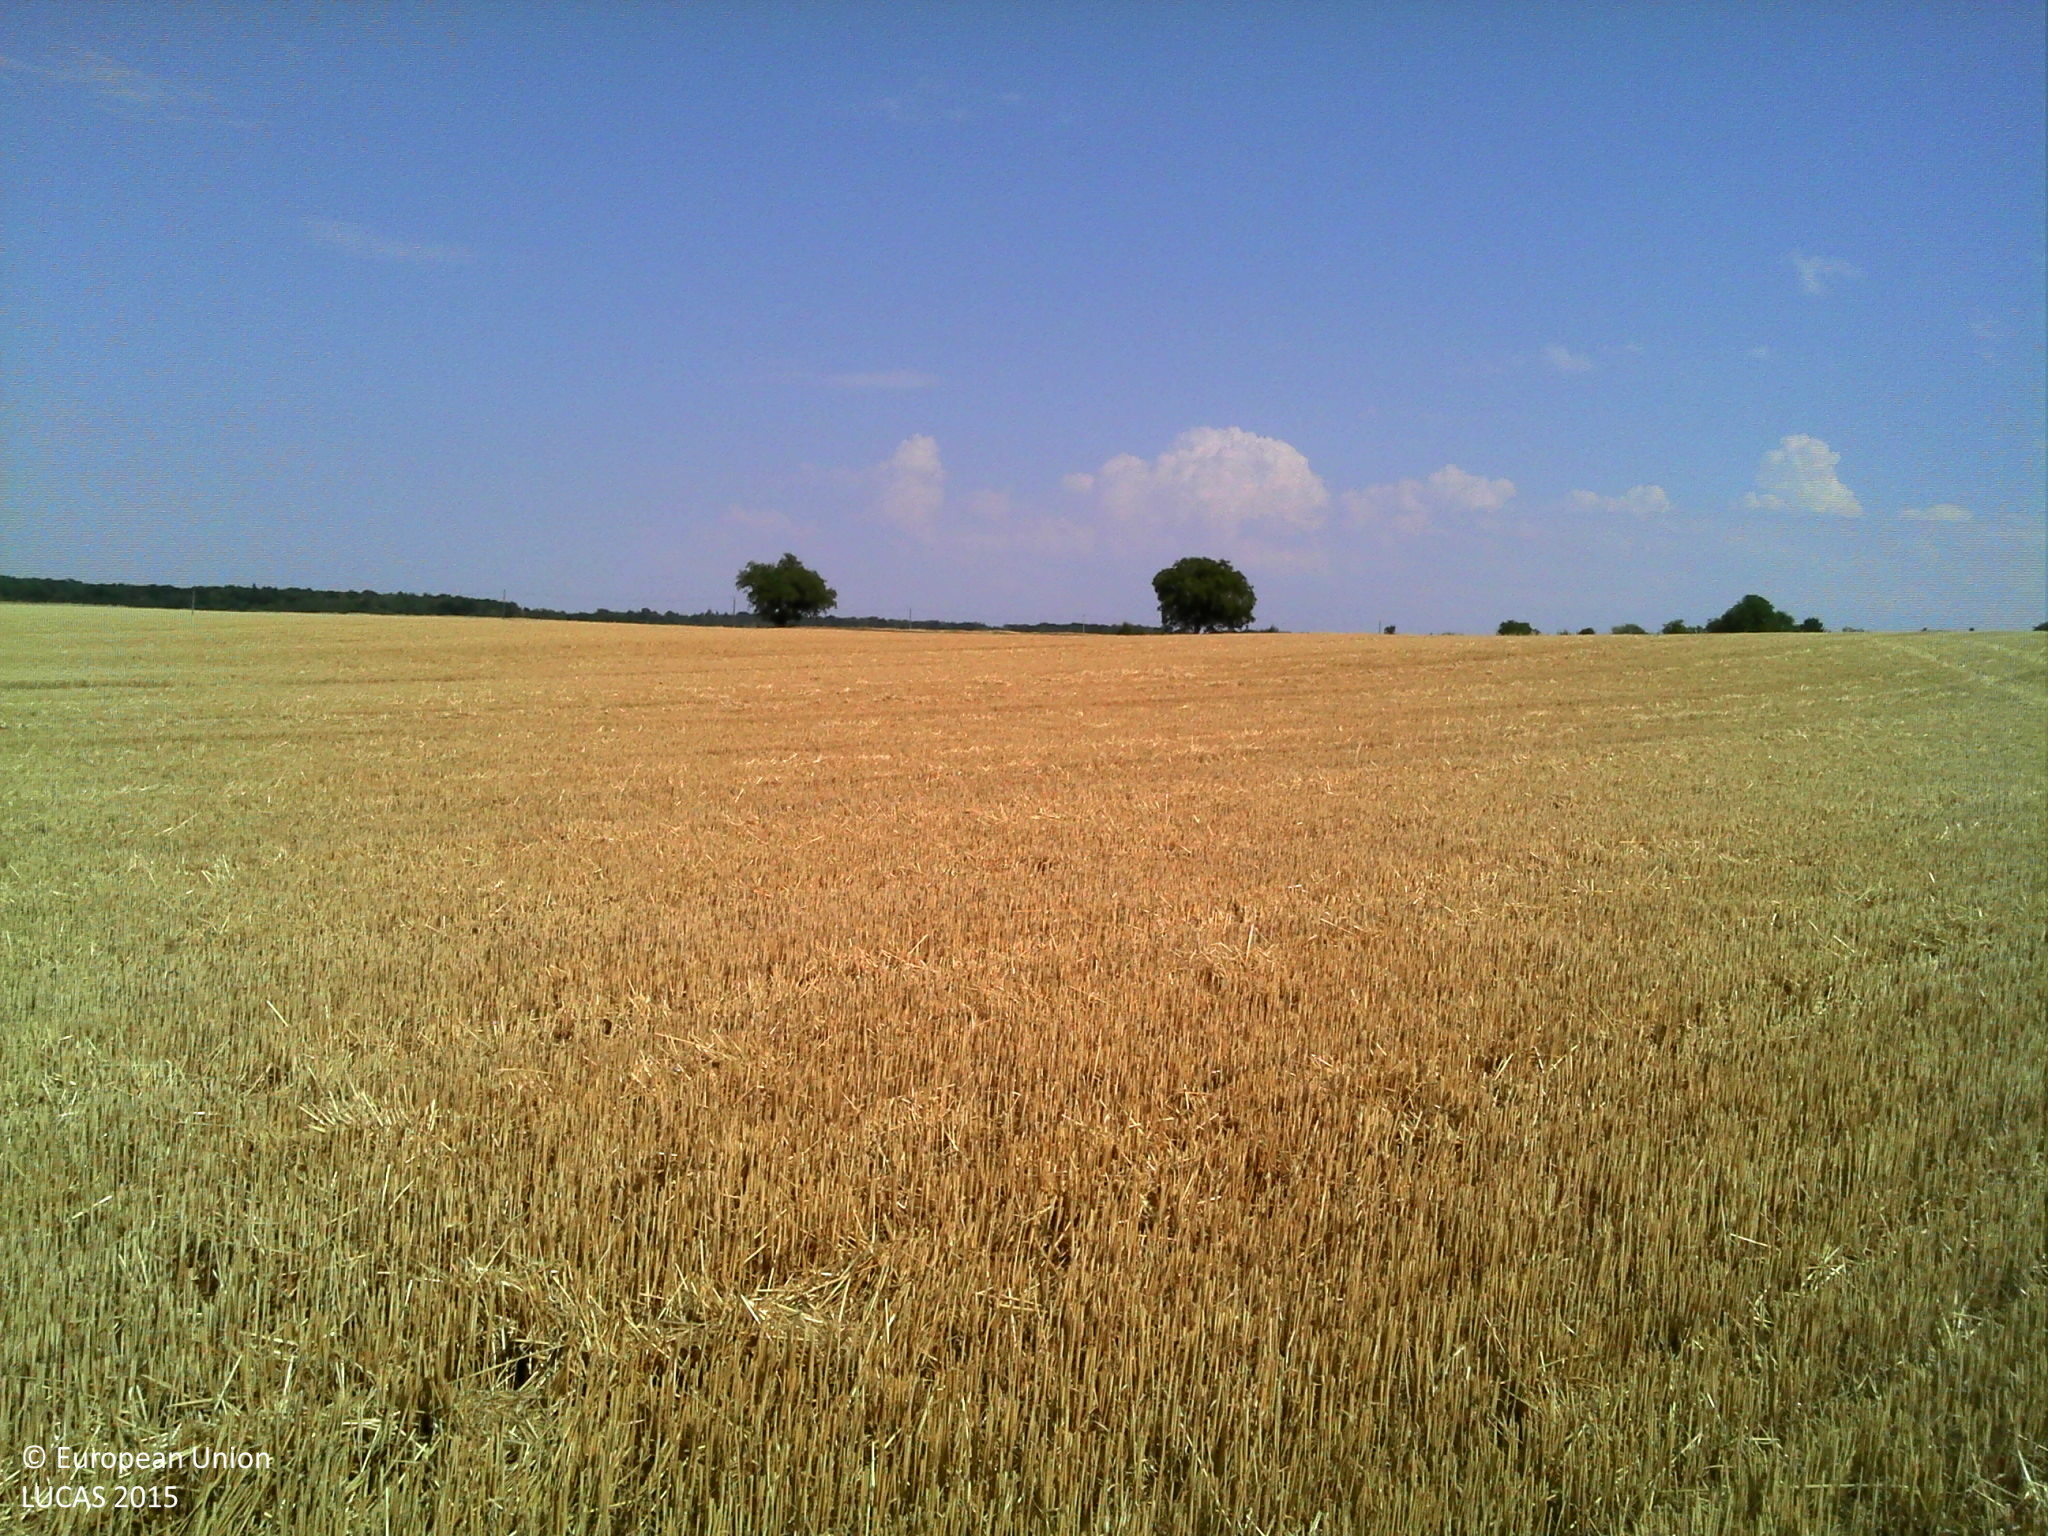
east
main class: Cropland
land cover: Common wheat
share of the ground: > 75 %
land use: Agriculture (excluding fallow land and kitchen gardens)
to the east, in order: Common wheat; Tracks
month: August
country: FR
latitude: 47.8472
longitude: 3.4337
